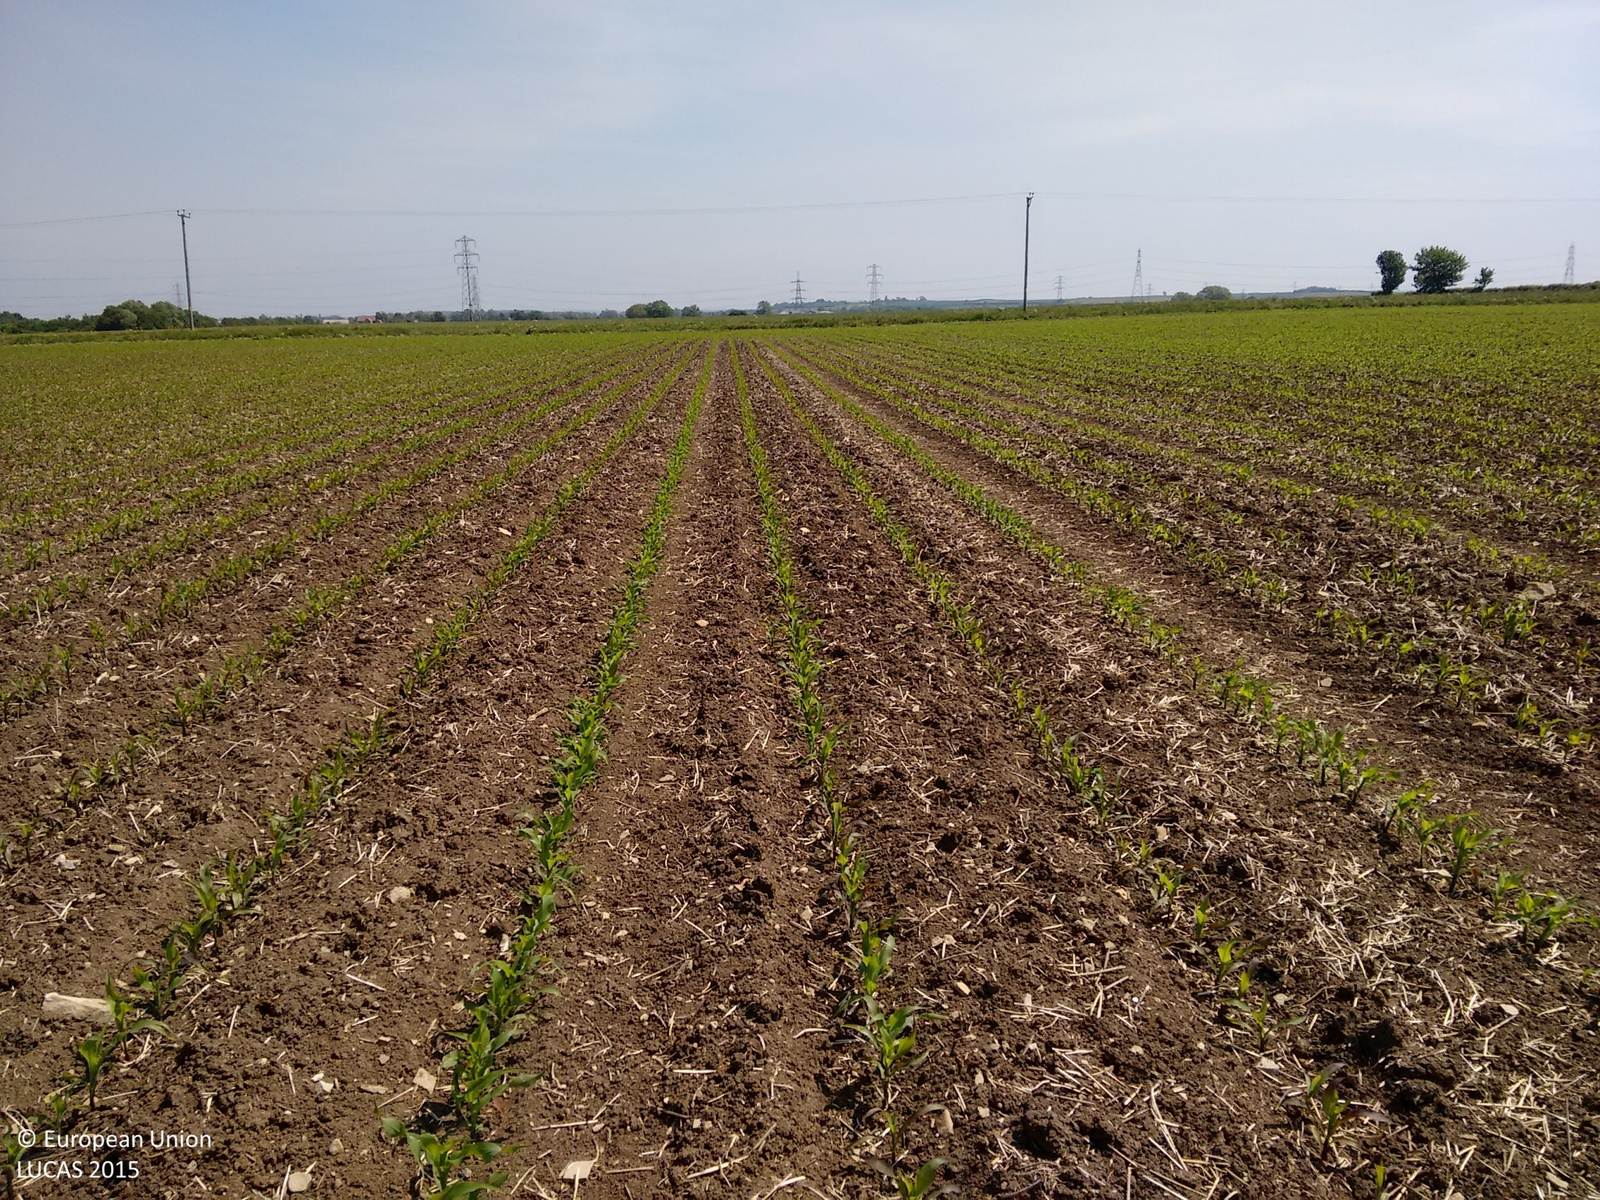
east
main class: Cropland
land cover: Maize
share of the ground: 10 - 25 %
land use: Agriculture (excluding fallow land and kitchen gardens)
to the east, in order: Maize; Grass margins; Paved roads, cycling and walking lanes; Grass margins; Electric lines; Common wheat
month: June
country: GB
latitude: 53.0093
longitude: -0.7868
